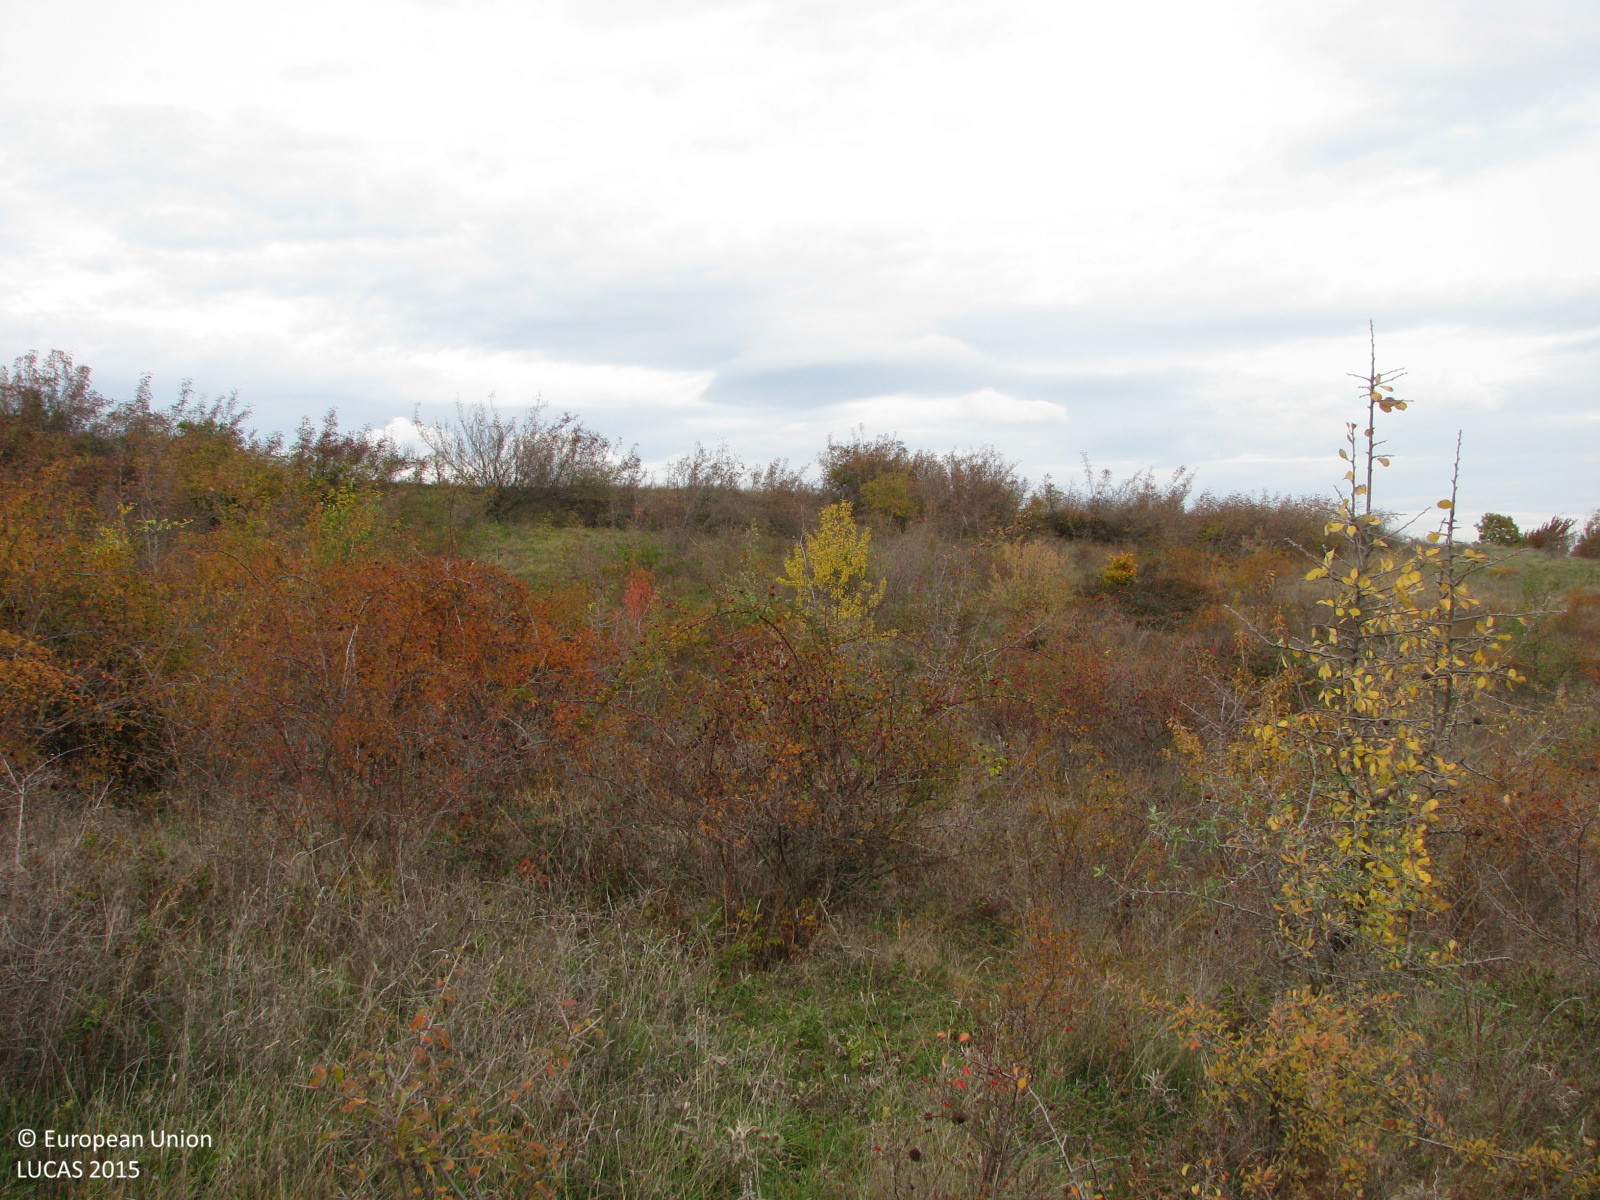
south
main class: Grassland
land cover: Grassland with sparse tree/shrub cover
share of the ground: > 75 %
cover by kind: herbaceous plants 85 %, shrubs 10 %, broadleaved forest trees 5 %
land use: Agriculture (excluding fallow land and kitchen gardens)
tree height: < 5 m
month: November
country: BG
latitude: 41.9710
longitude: 26.3856
